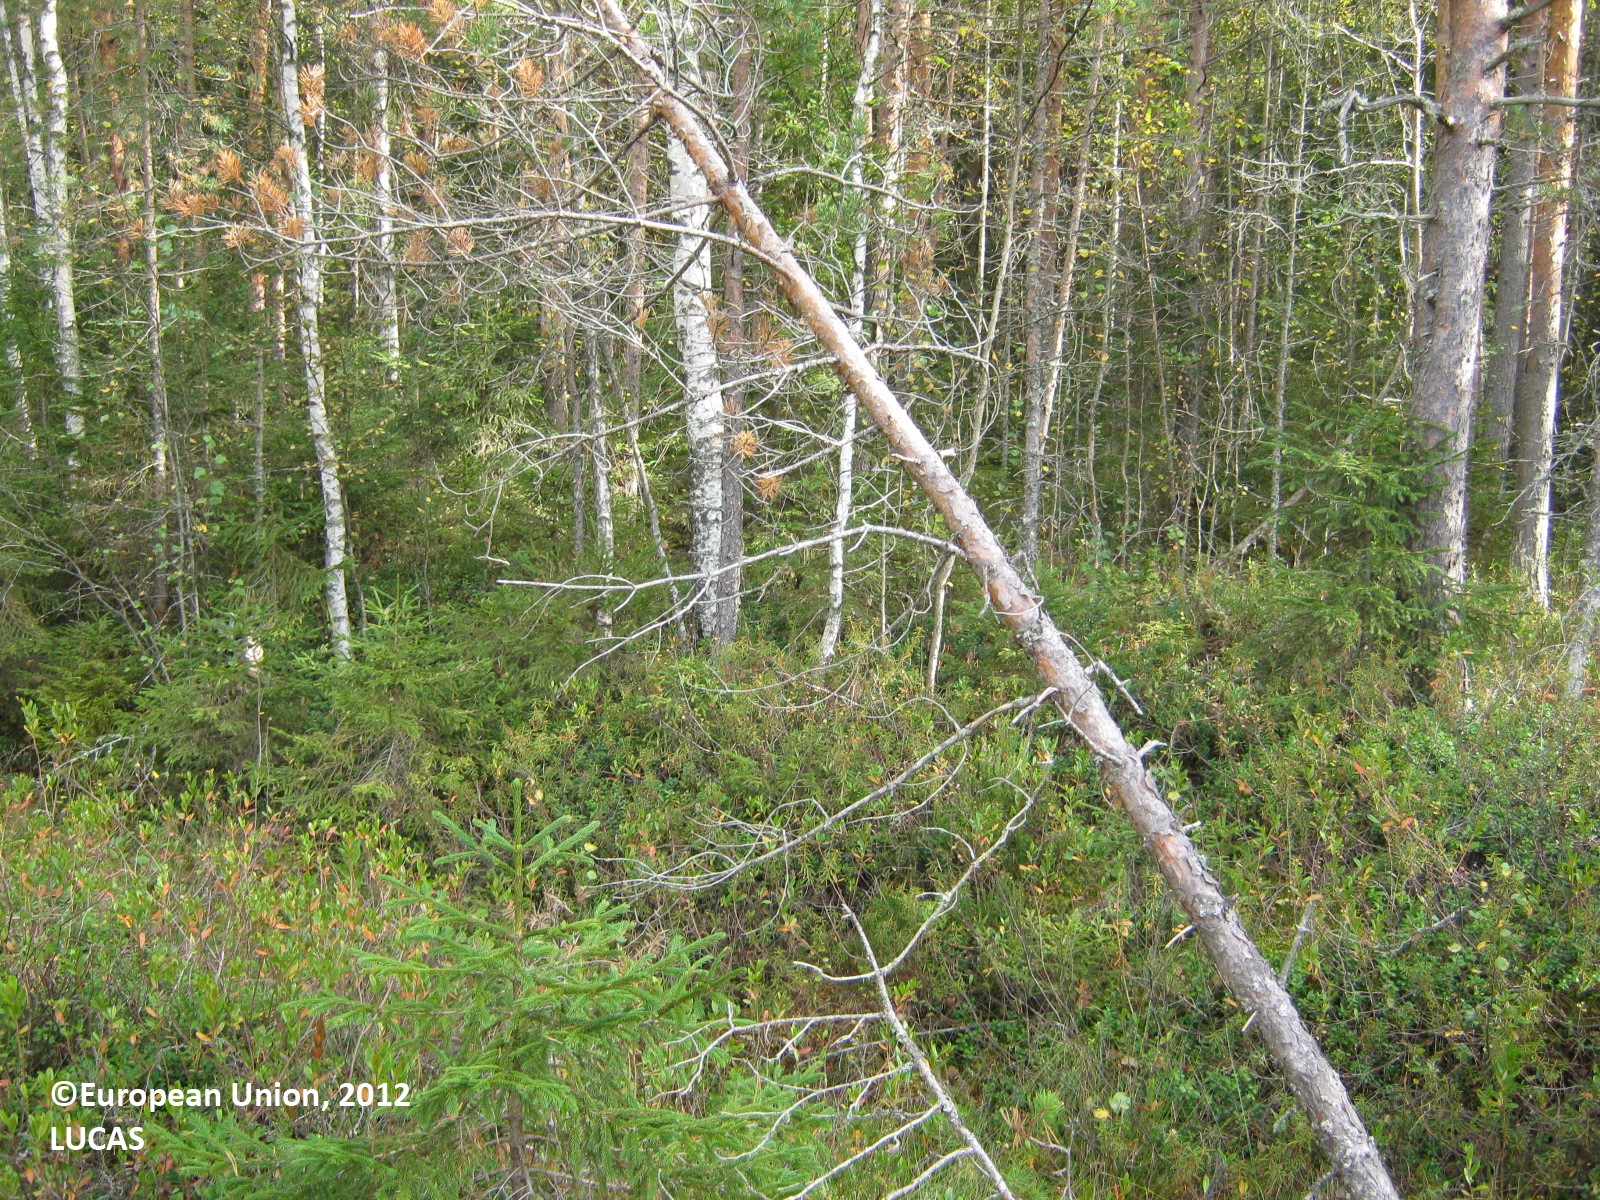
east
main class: Woodland
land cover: Pine dominated coniferous woodland
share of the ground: 50 - 75 %
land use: Forestry
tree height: < 5 m
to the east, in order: Pine dominated coniferous woodland; Ditches and canals; Spruce dominated coniferous woodland; Ditches and canals; Spruce dominated coniferous woodland; Tracks; Spruce dominated coniferous woodland
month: September
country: FI
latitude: 60.9818
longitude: 28.2253
